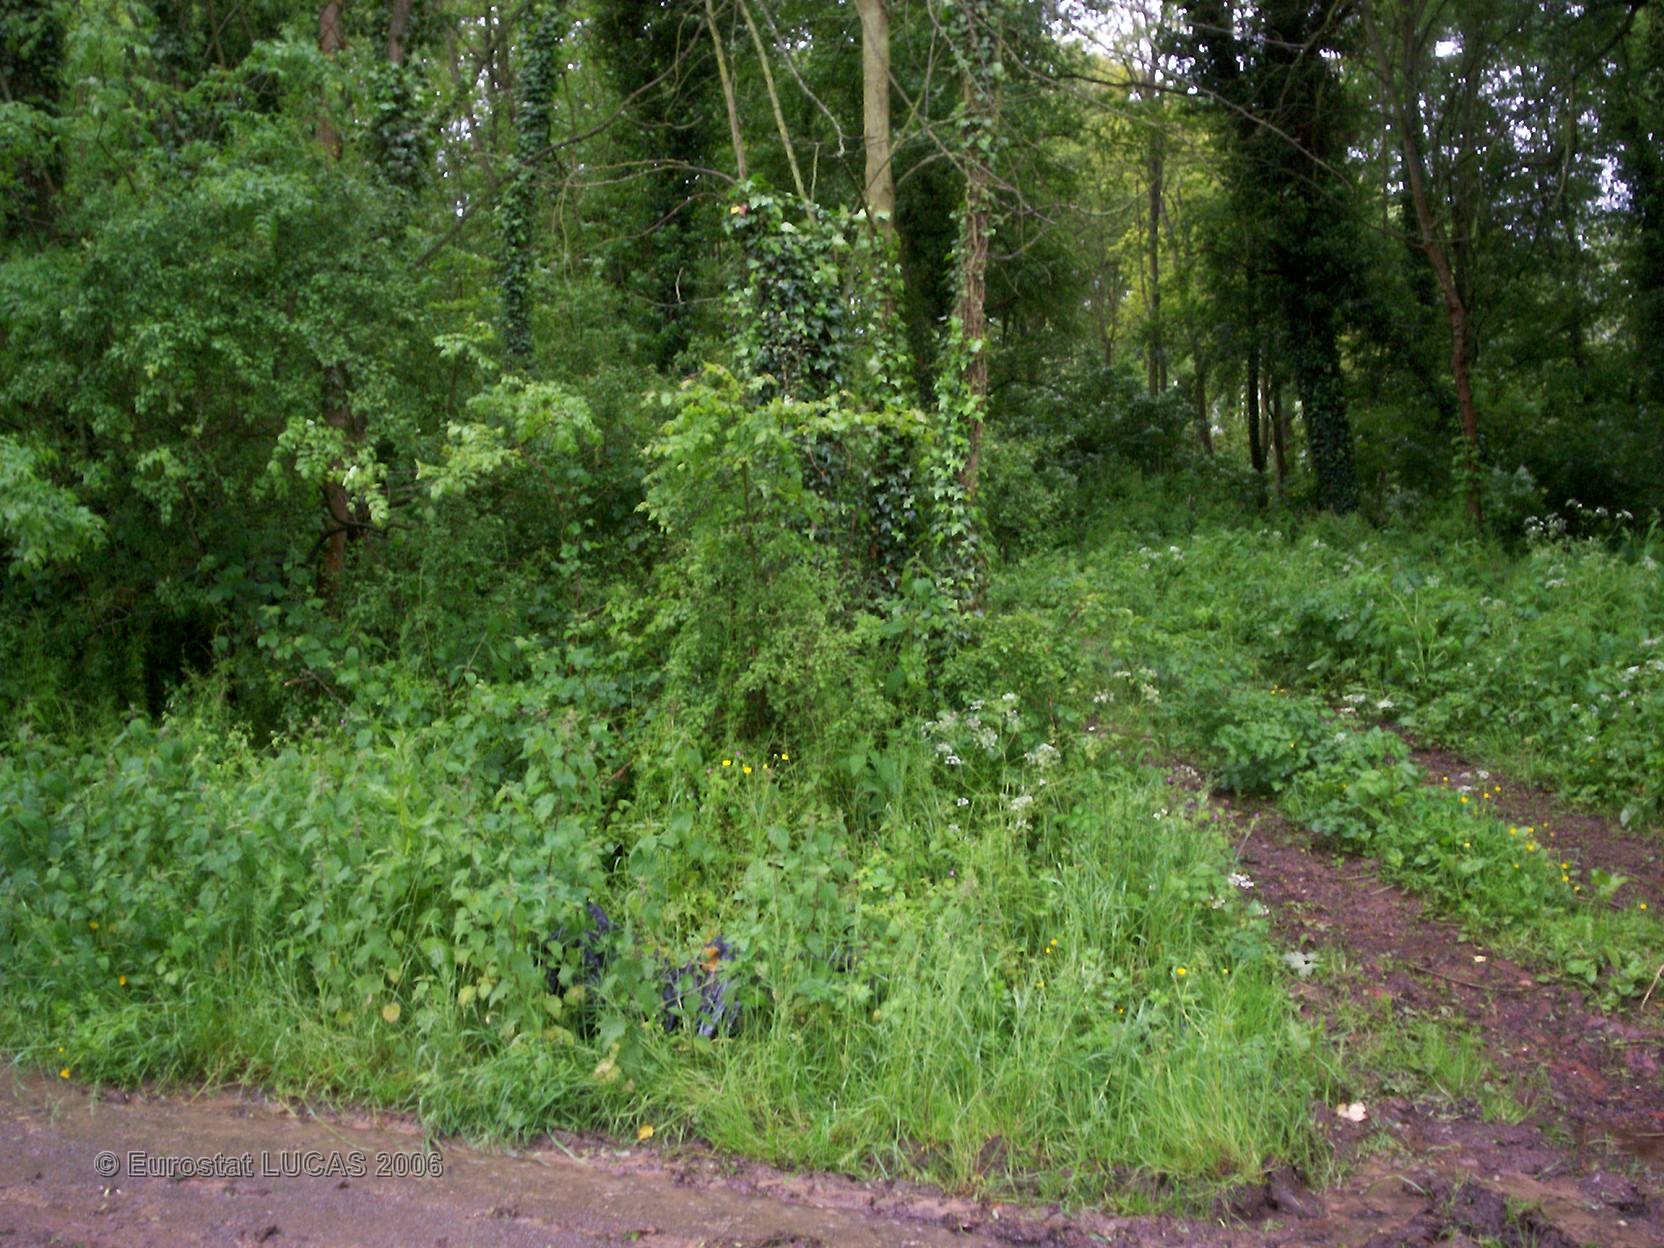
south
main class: Grassland
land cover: Grassland with sparse tree/shrub cover
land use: Agriculture (excluding fallow land and kitchen gardens)
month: May
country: FR
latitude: 50.4255
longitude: 2.5130
